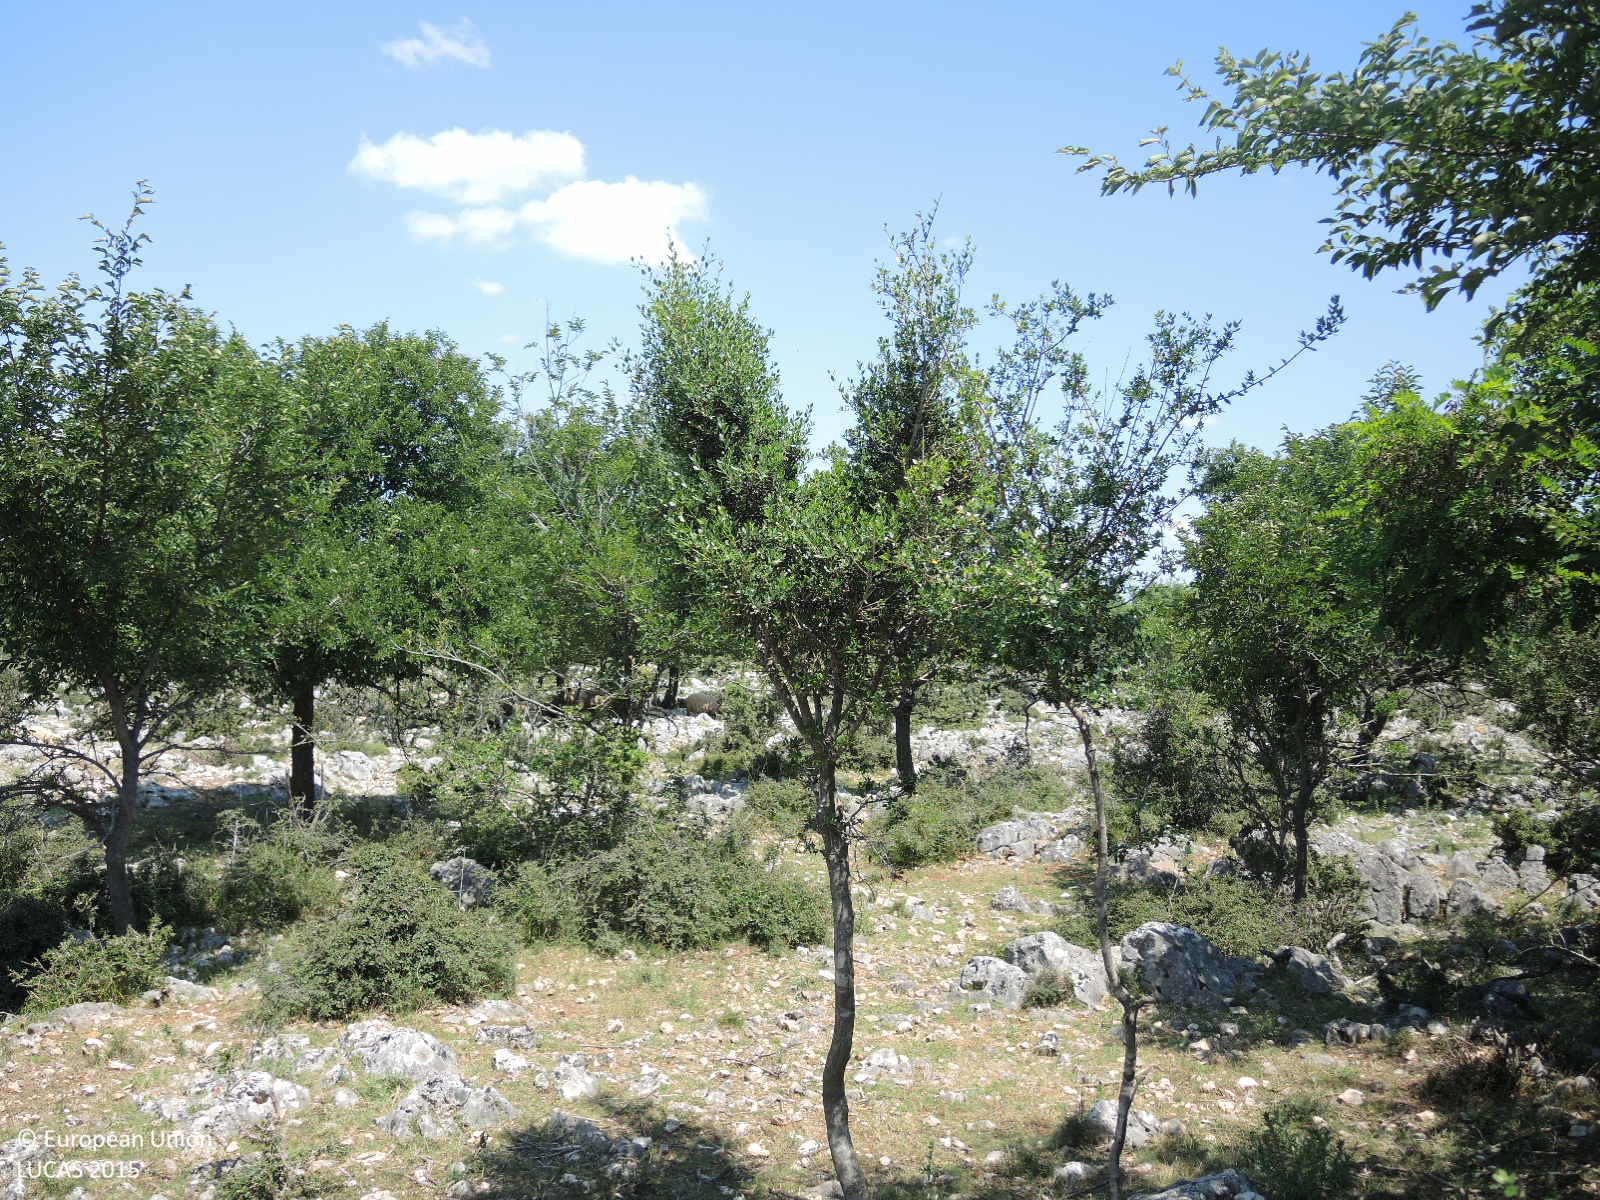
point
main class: Woodland
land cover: Broadleaved woodland
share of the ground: 25 - 50 %
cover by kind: broadleaved forest trees 45 %, herbaceous plants 25 %, shrubs 10 %, consolidated bare surface 10 %, unconsolidated bare surface 10 %
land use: Semi-natural and natural areas not in use
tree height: < 5 m
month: May
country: HR
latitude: 44.0256
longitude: 15.4688
